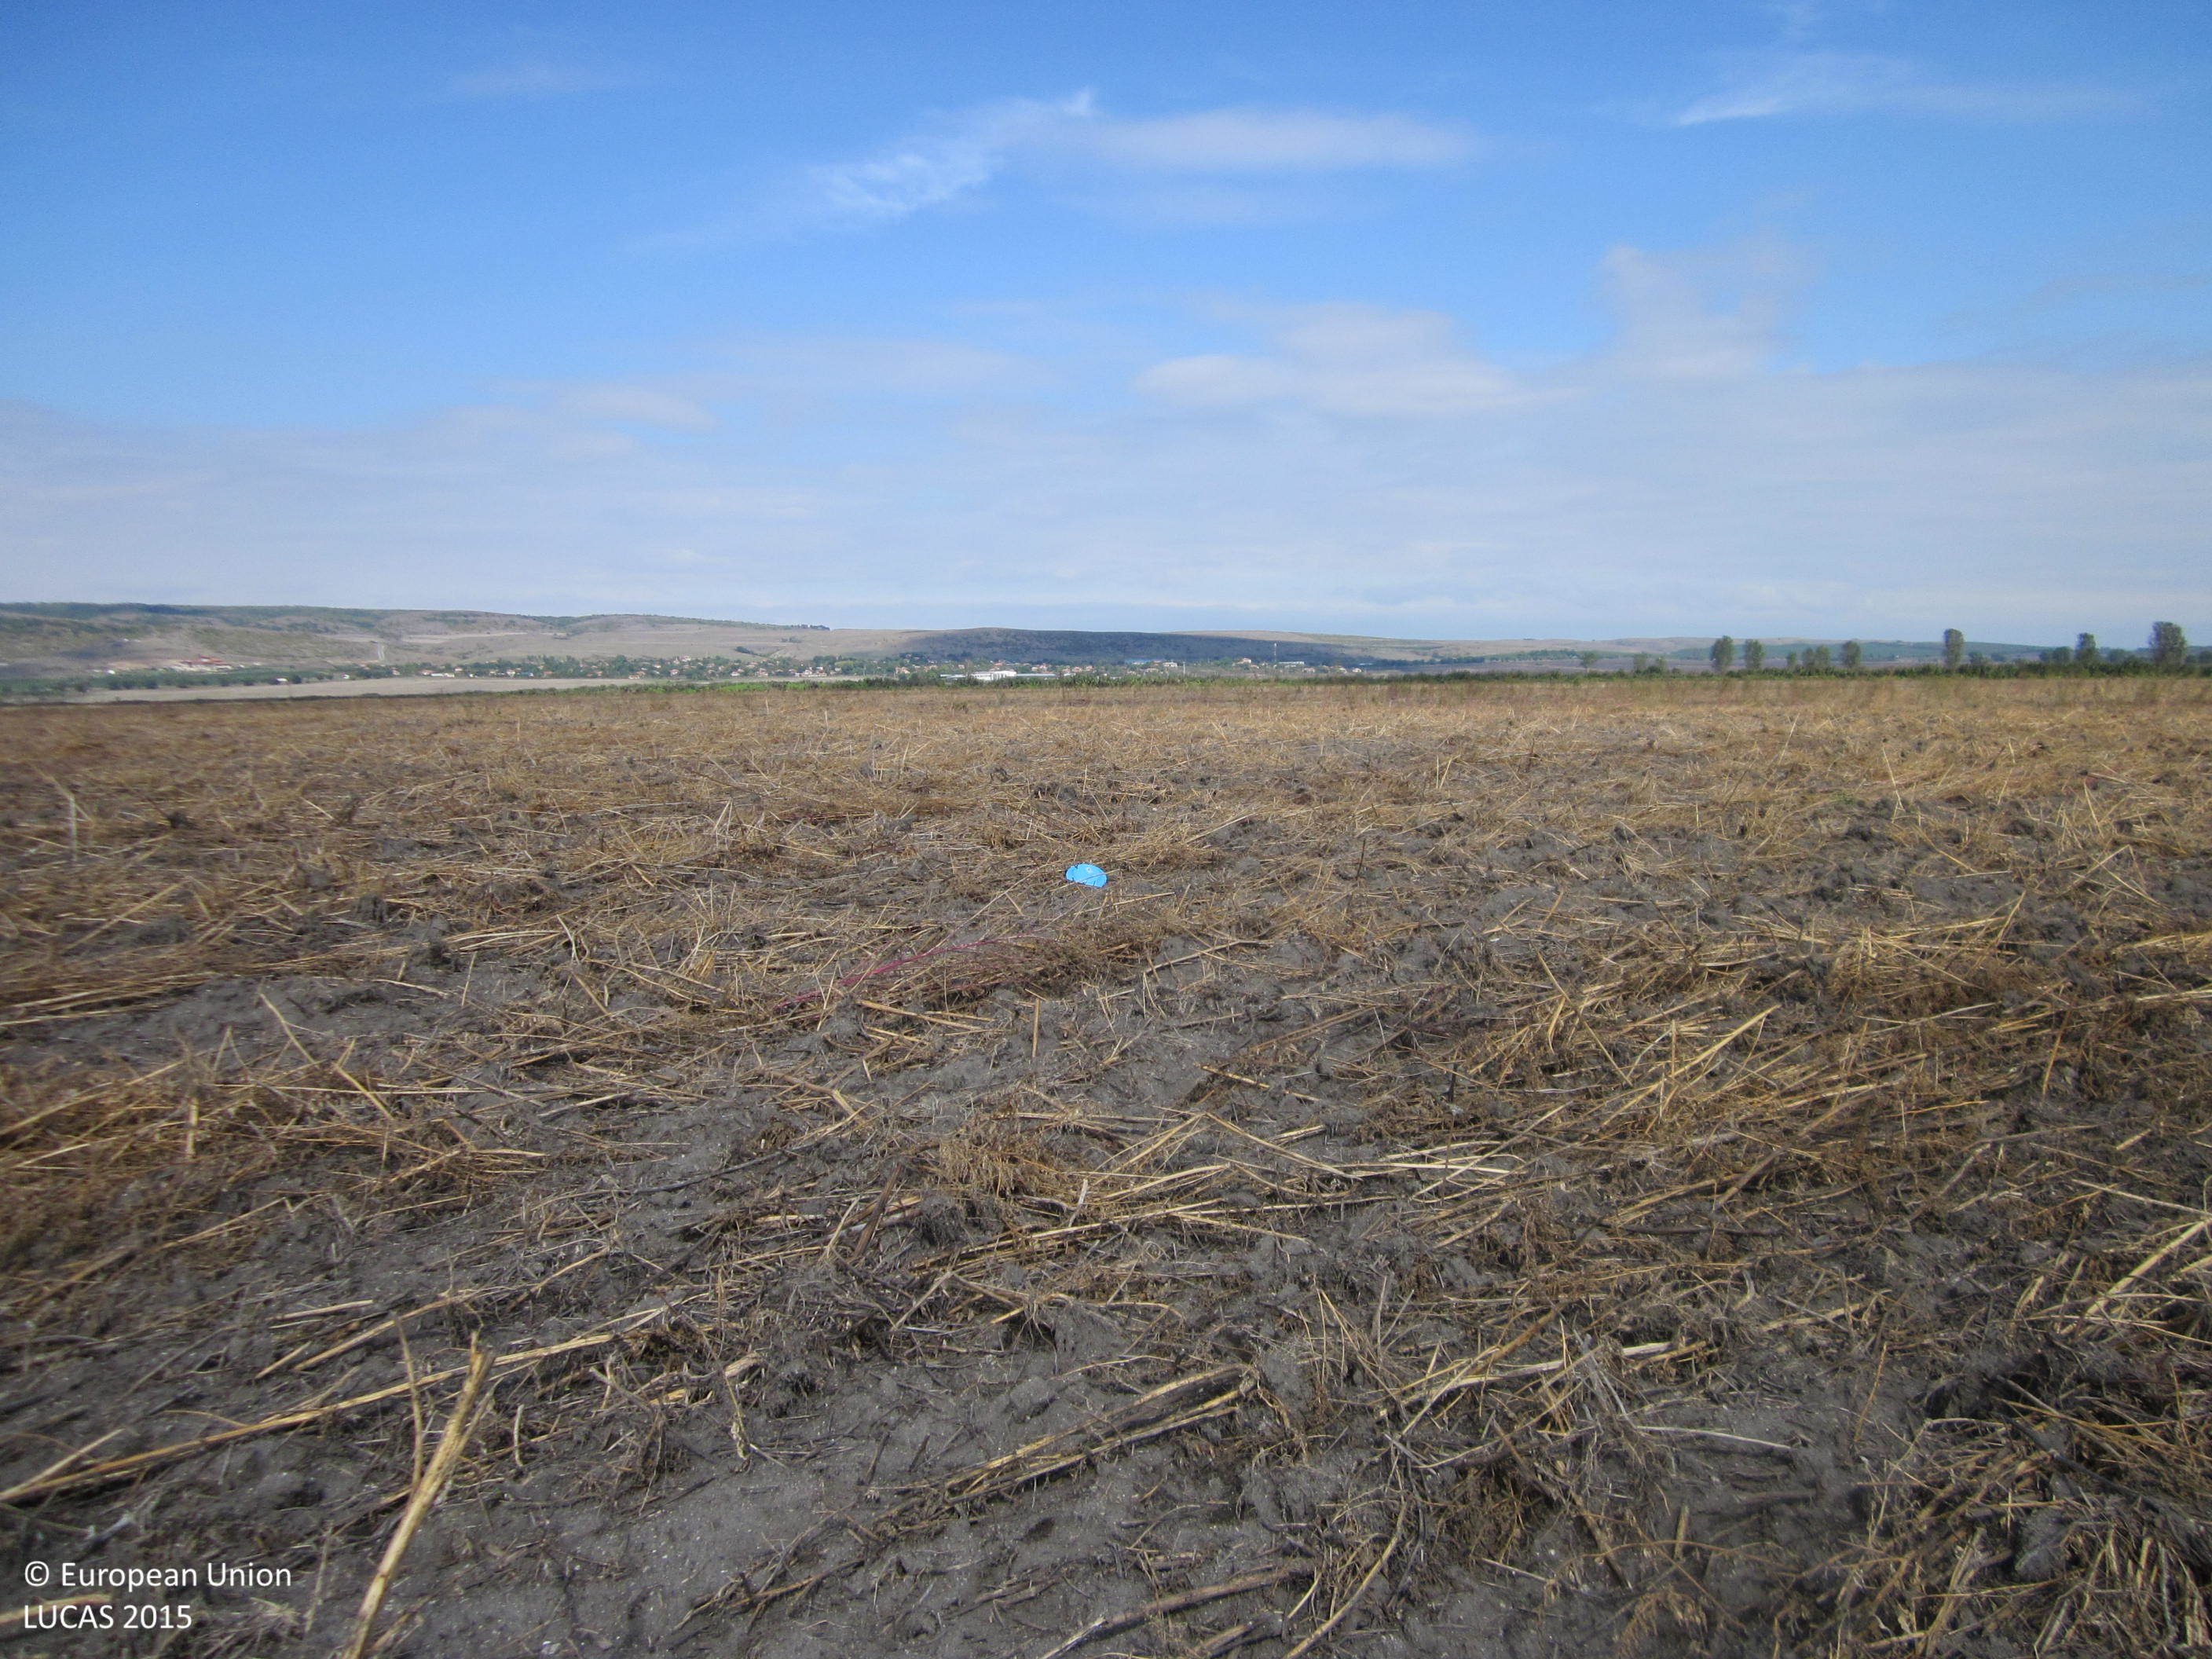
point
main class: Cropland
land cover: Sunflower
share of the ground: 10 - 25 %
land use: Agriculture (excluding fallow land and kitchen gardens)
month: October
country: BG
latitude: 42.6207
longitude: 26.7918
